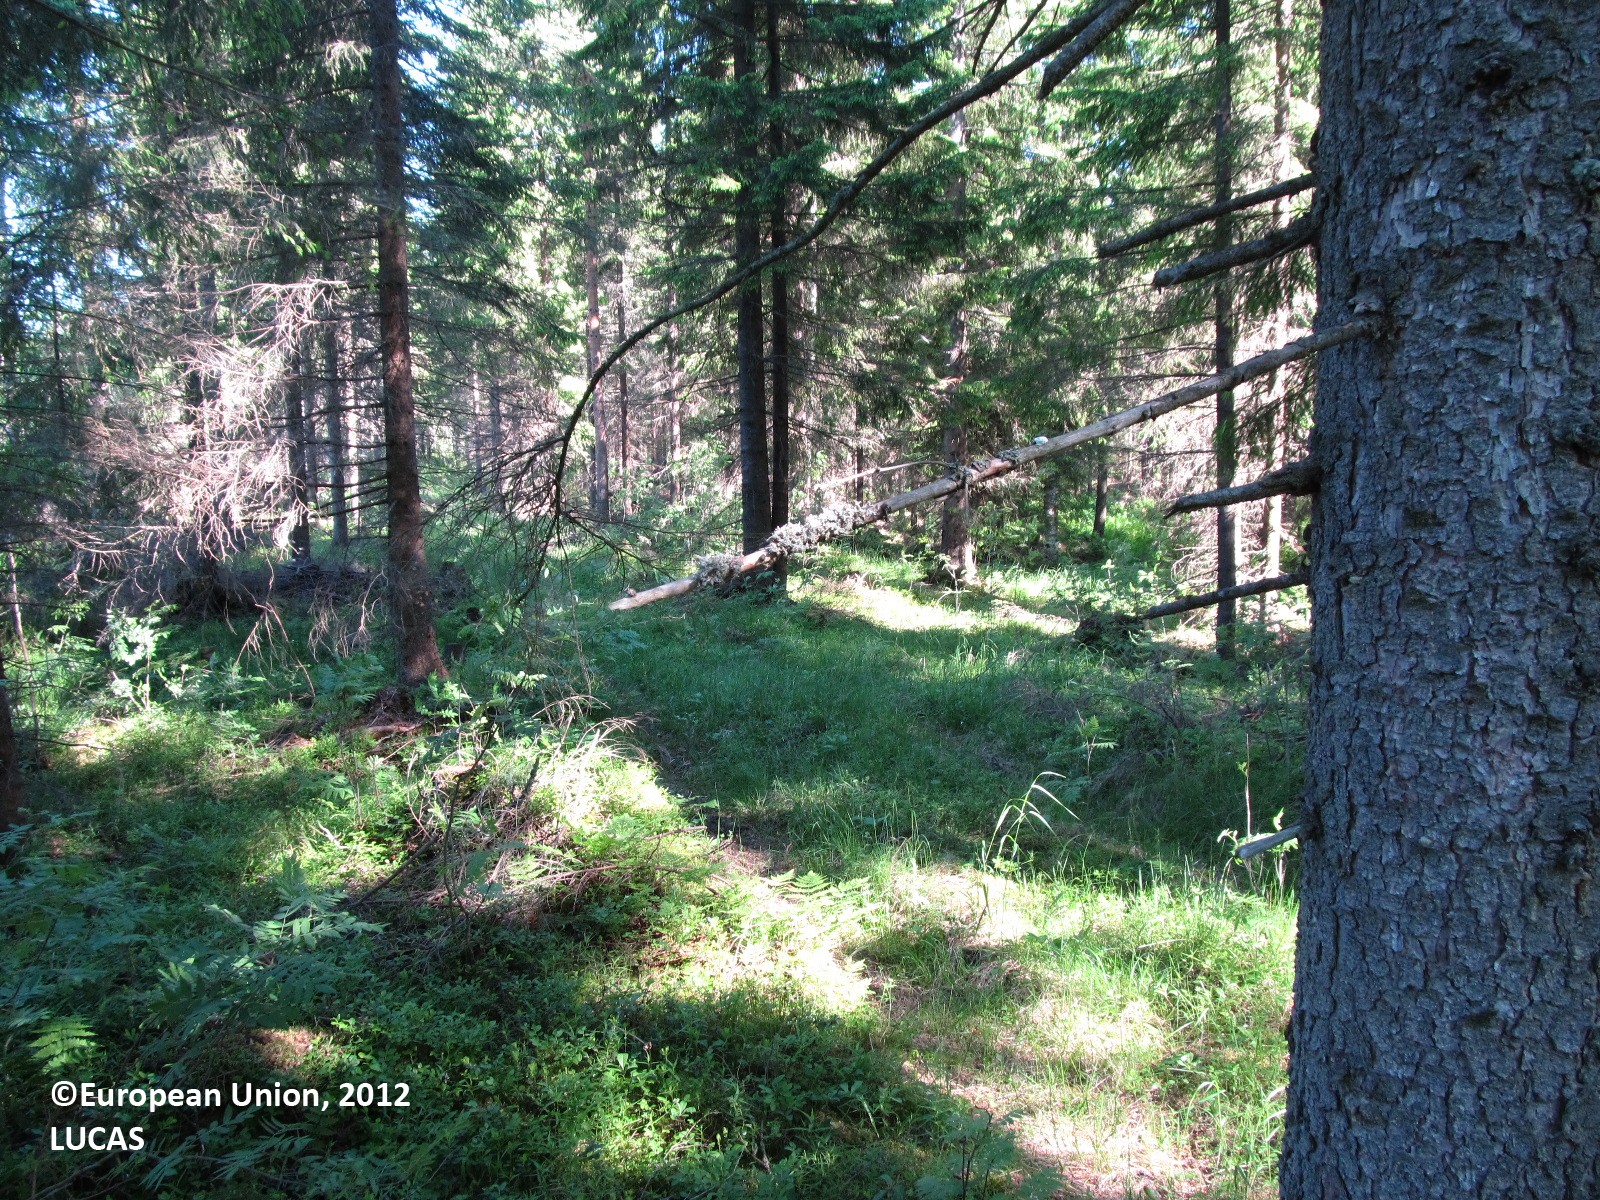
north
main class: Woodland
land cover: Spruce dominated coniferous woodland
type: boreal forest
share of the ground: 50 - 75 %
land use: Forestry
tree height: > 5 m
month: June
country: FI
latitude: 62.6801
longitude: 27.5691
